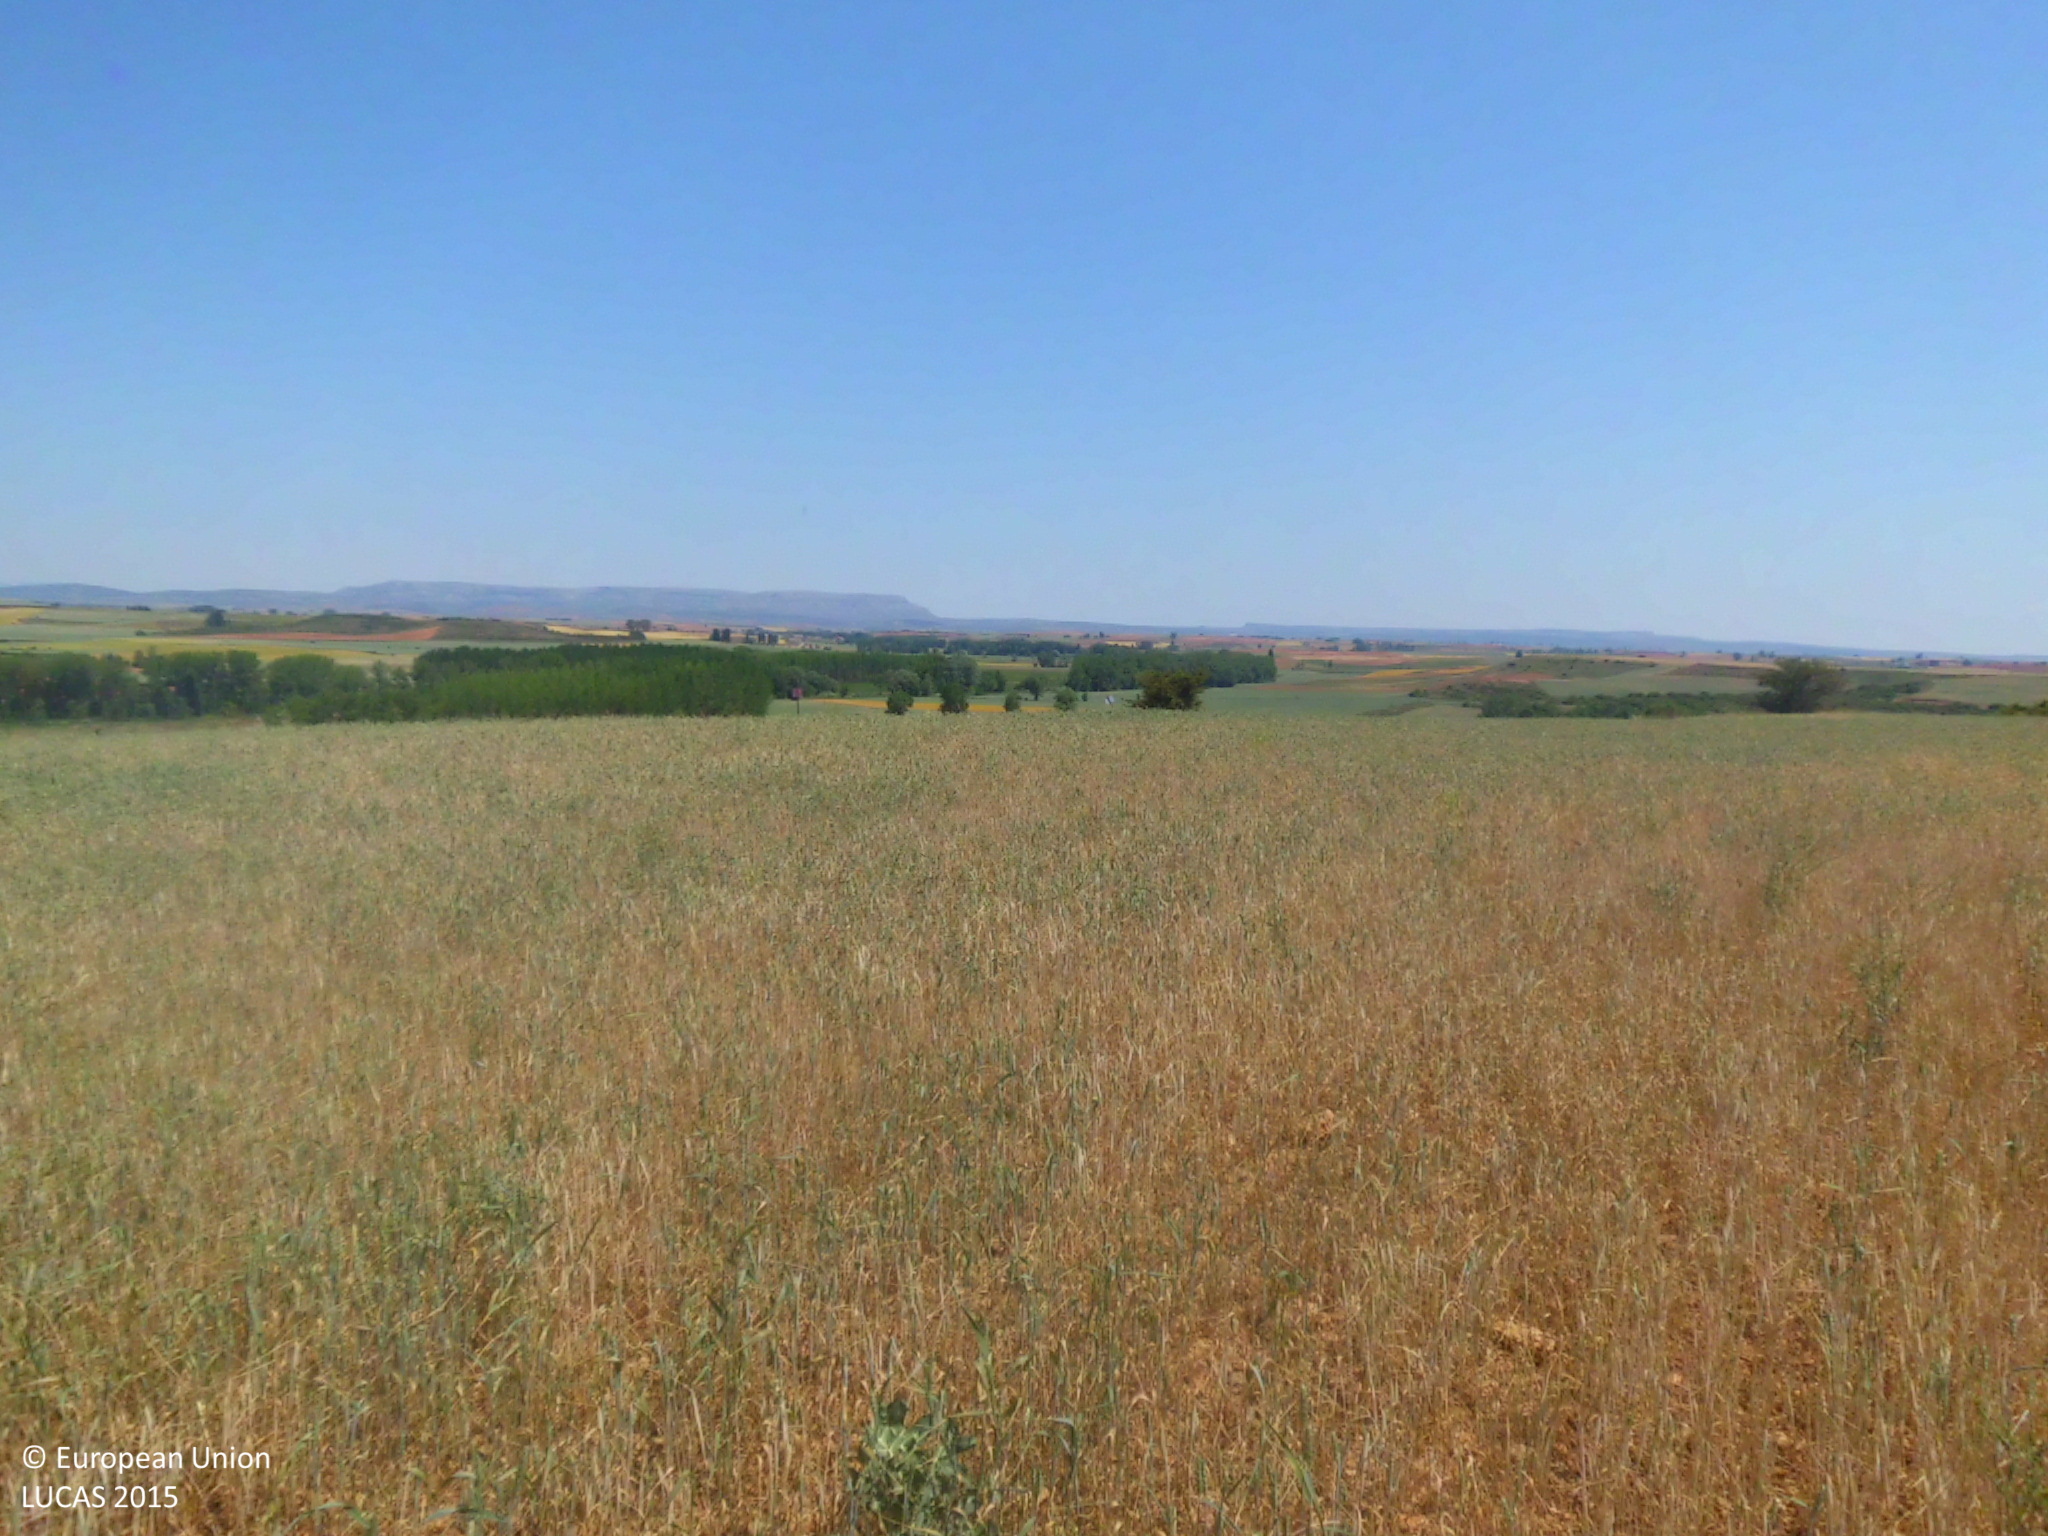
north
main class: Cropland
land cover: Common wheat
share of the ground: > 75 %
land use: Agriculture (excluding fallow land and kitchen gardens)
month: June
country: ES
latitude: 42.5048
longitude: -4.2238
